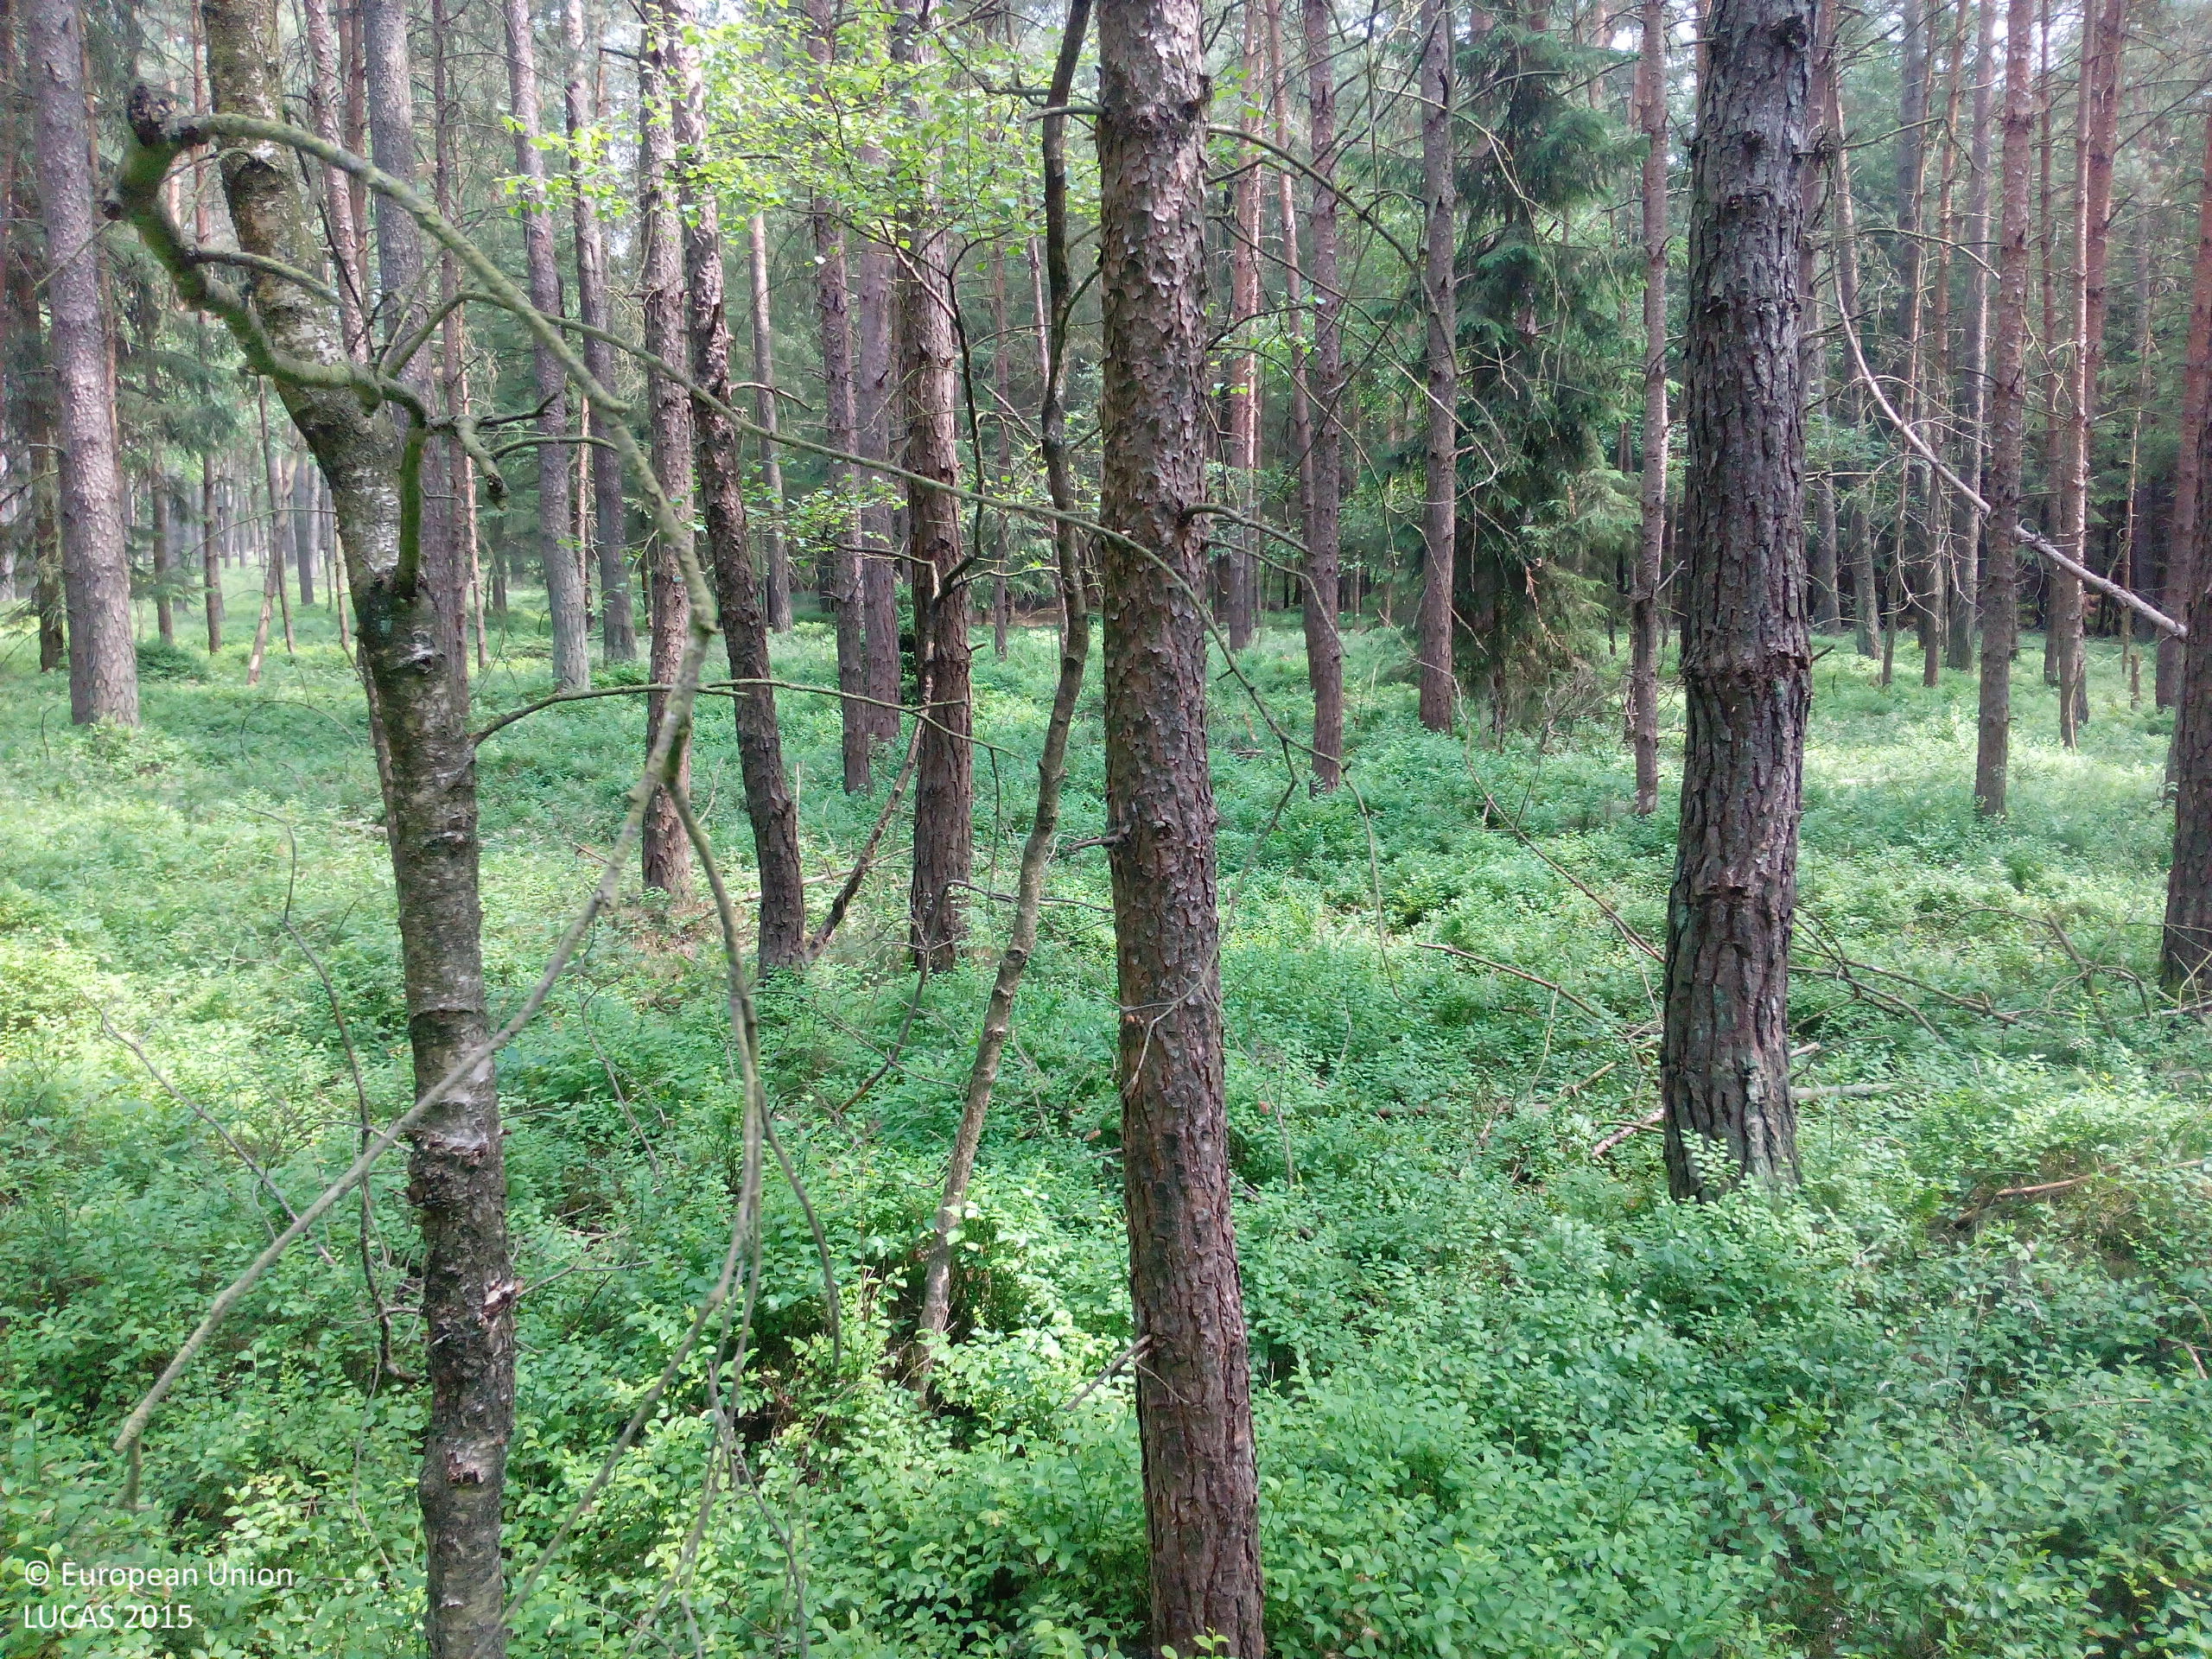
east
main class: Woodland
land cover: Pine dominated coniferous woodland
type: hemiboreal forest and nemoral coniferous forest and mixed broadleaved-coniferous forest
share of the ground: > 75 %
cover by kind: coniferous forest trees 75 %, broadleaved forest trees 15 %, shrubs 10 %
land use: Forestry
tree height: > 5 m
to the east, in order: Pine dominated coniferous woodland; Other coniferous woodland; Pine dominated coniferous woodland; Other coniferous woodland
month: July
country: DE
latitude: 52.7546
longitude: 10.2814
